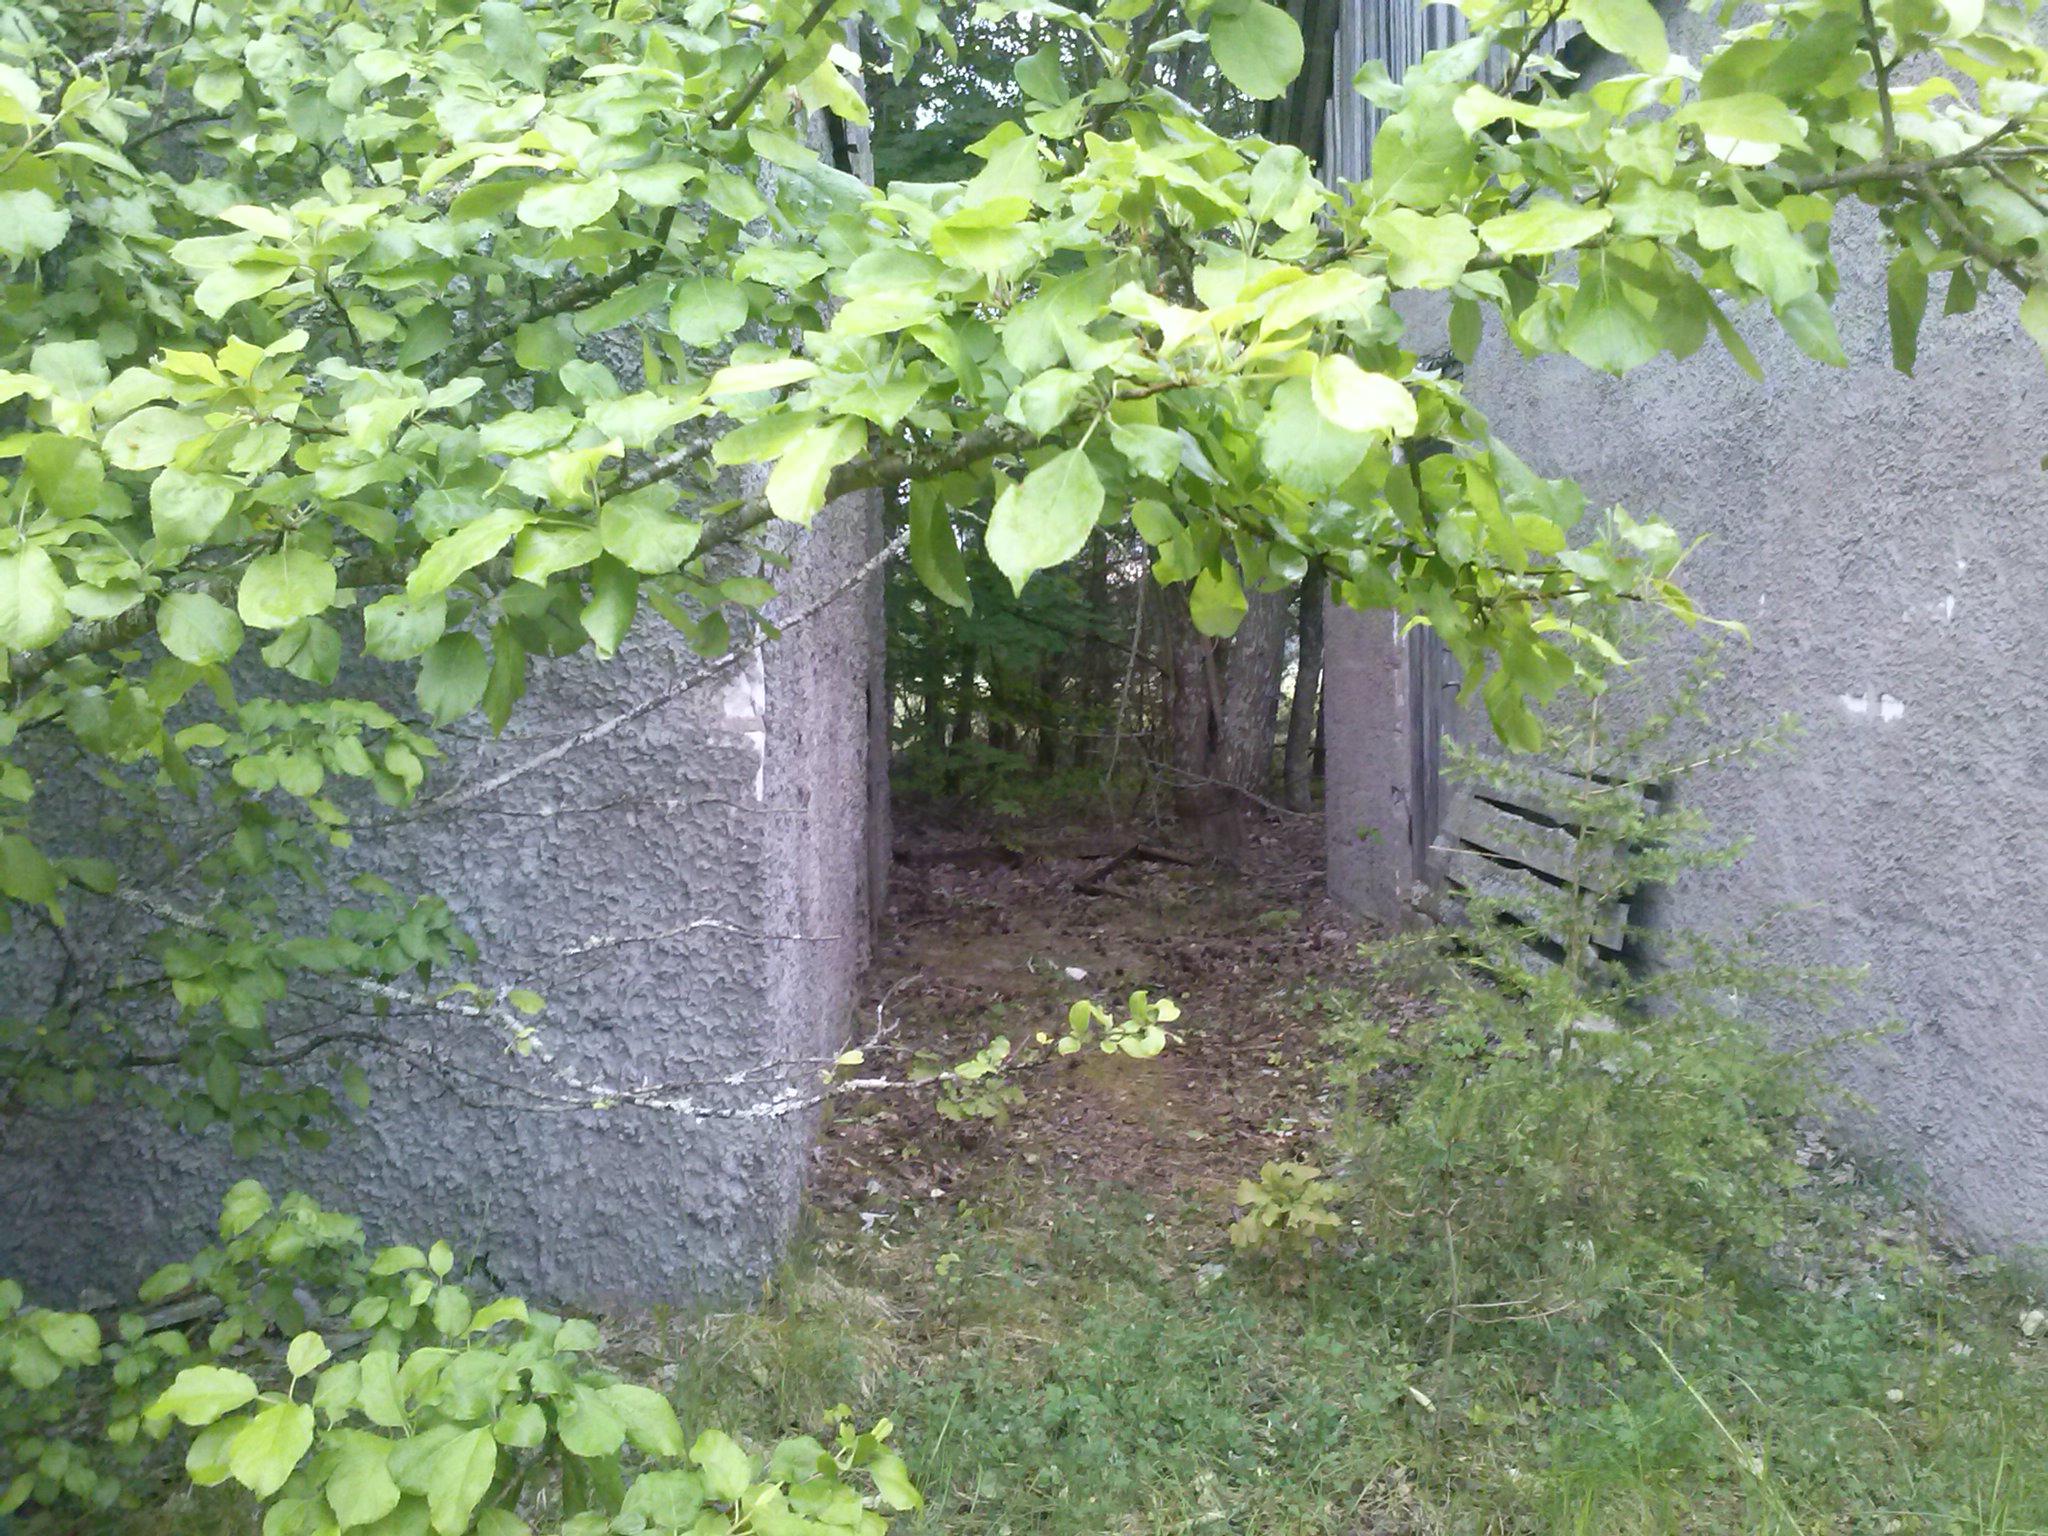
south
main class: Woodland
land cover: Broadleaved woodland
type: non-riverine alder, birch or aspen forest
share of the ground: 50 - 75 %
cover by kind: broadleaved forest trees 50 %, herbaceous plants 40 %, coniferous forest trees 5 %, shrubs 5 %
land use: Abandoned areas
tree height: > 5 m
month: June
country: LV
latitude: 56.9127
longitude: 27.1993
